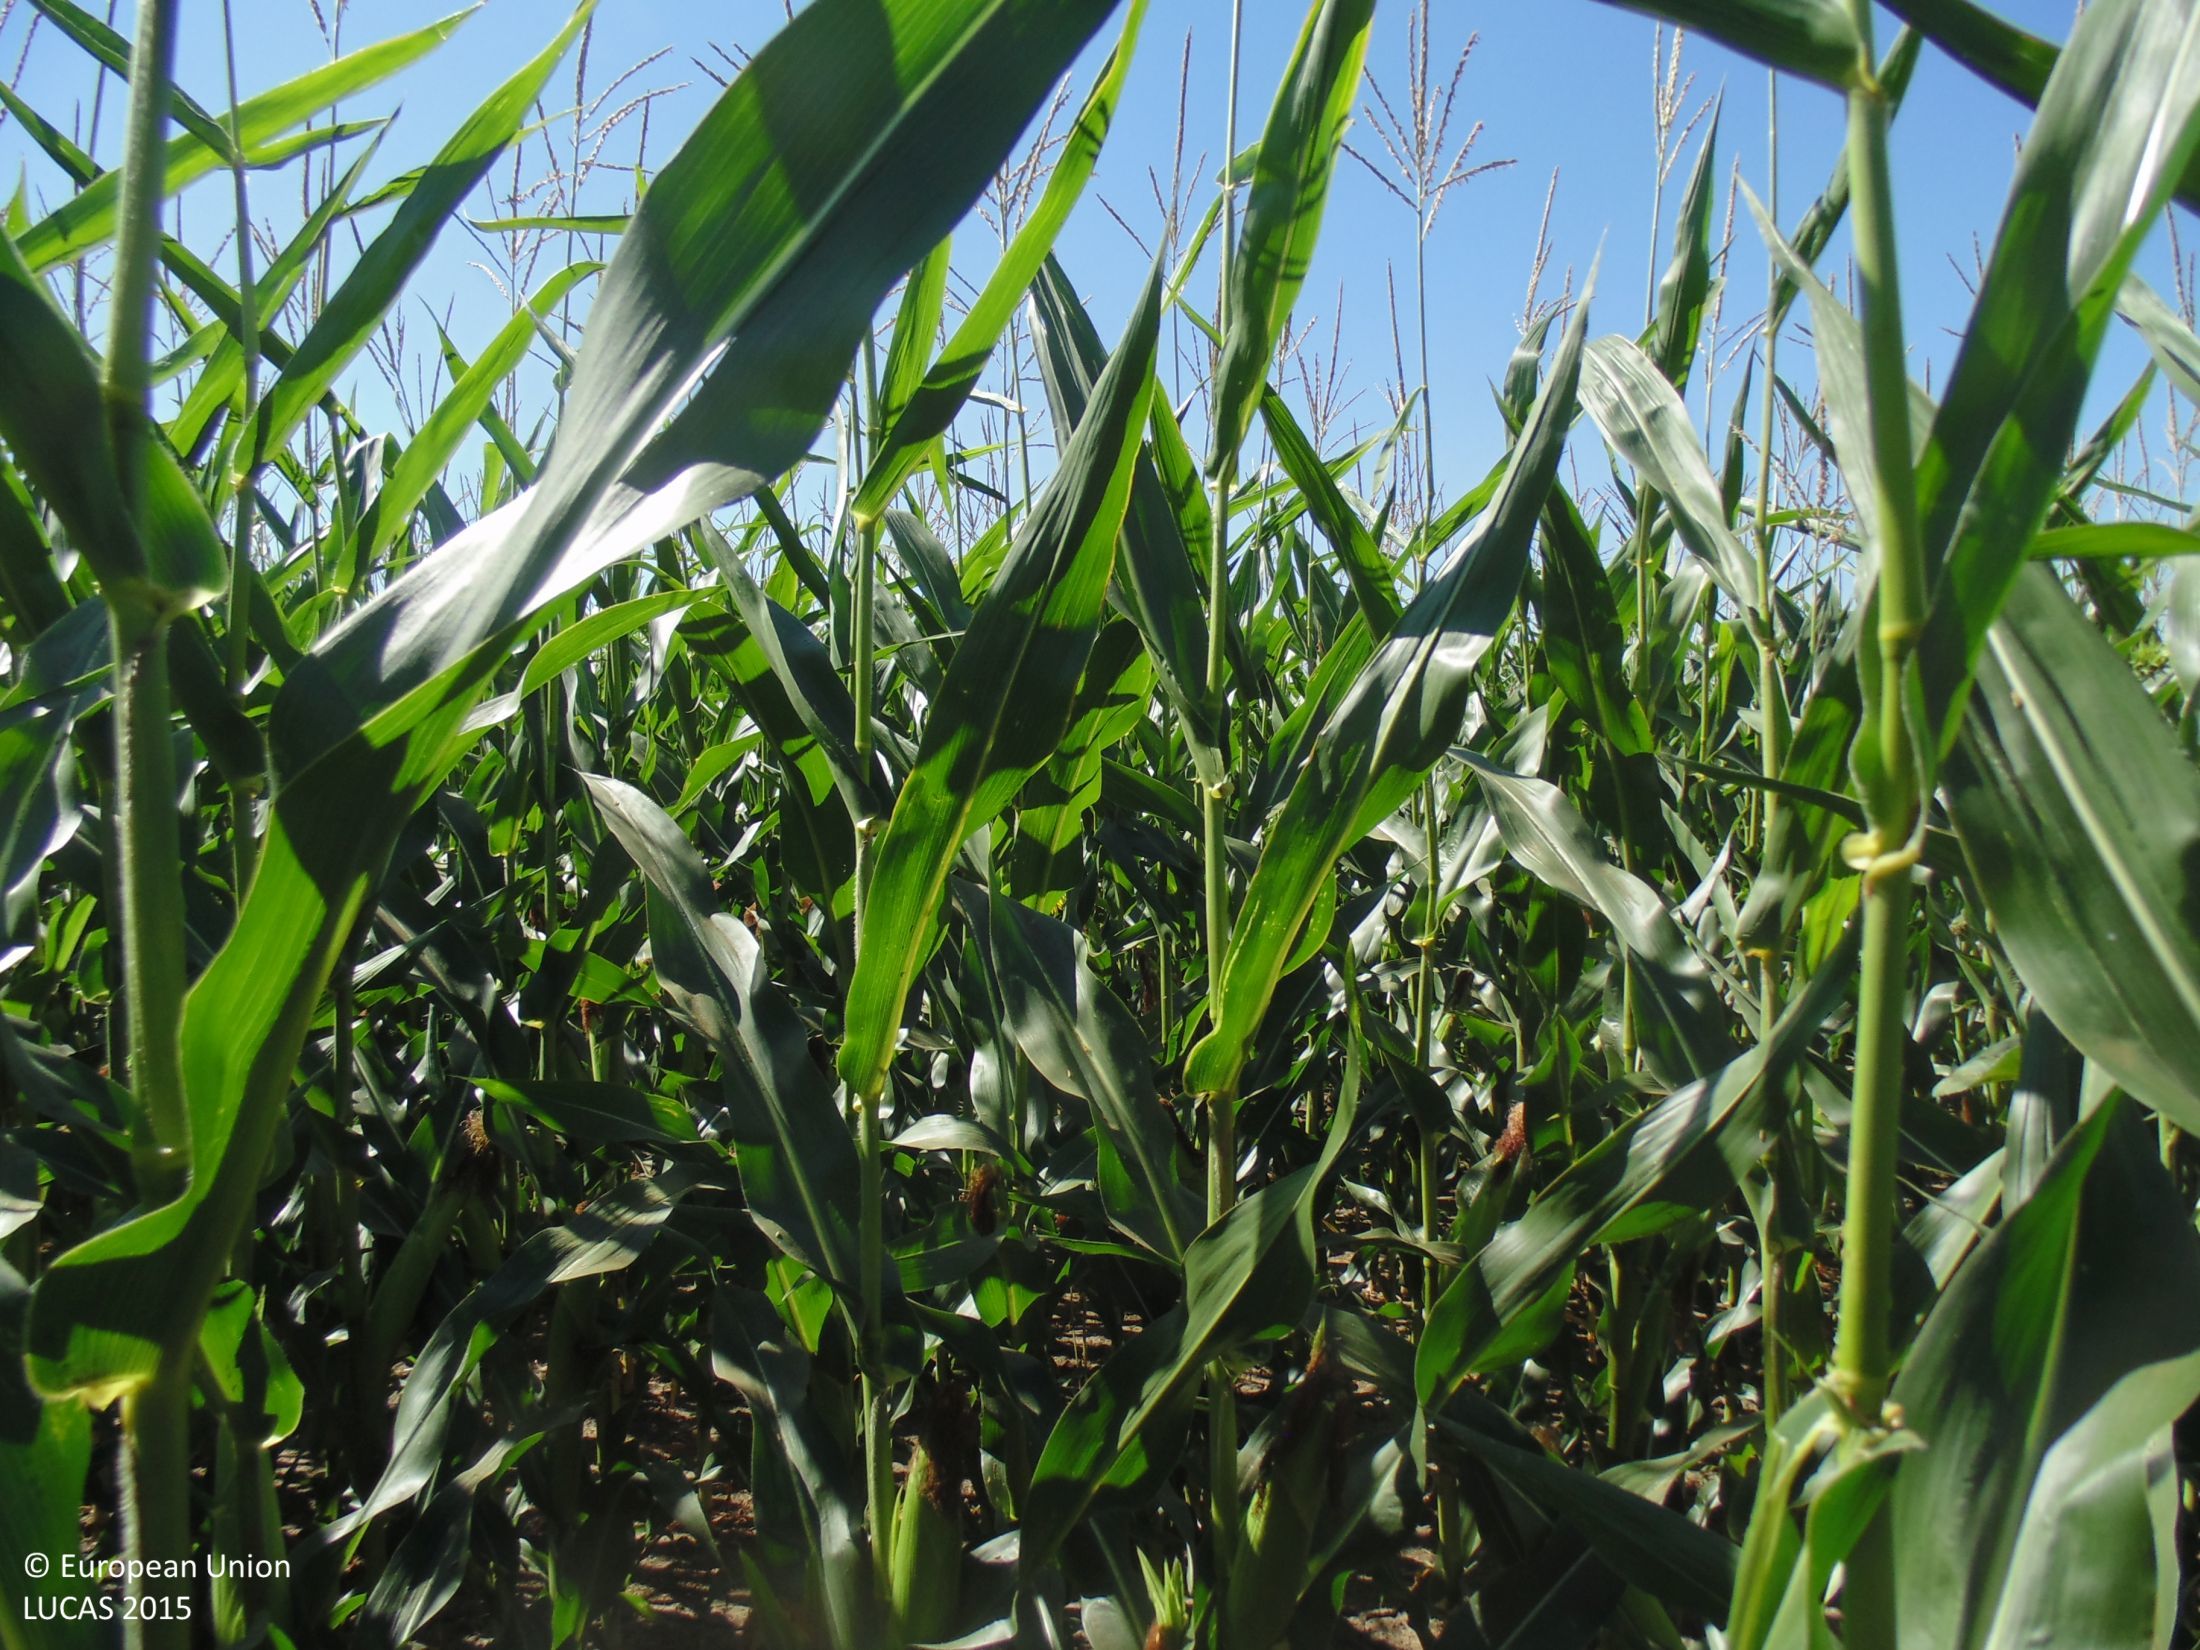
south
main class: Cropland
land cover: Maize
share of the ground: > 75 %
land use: Agriculture (excluding fallow land and kitchen gardens)
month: July
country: BG
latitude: 43.7088
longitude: 27.8534
